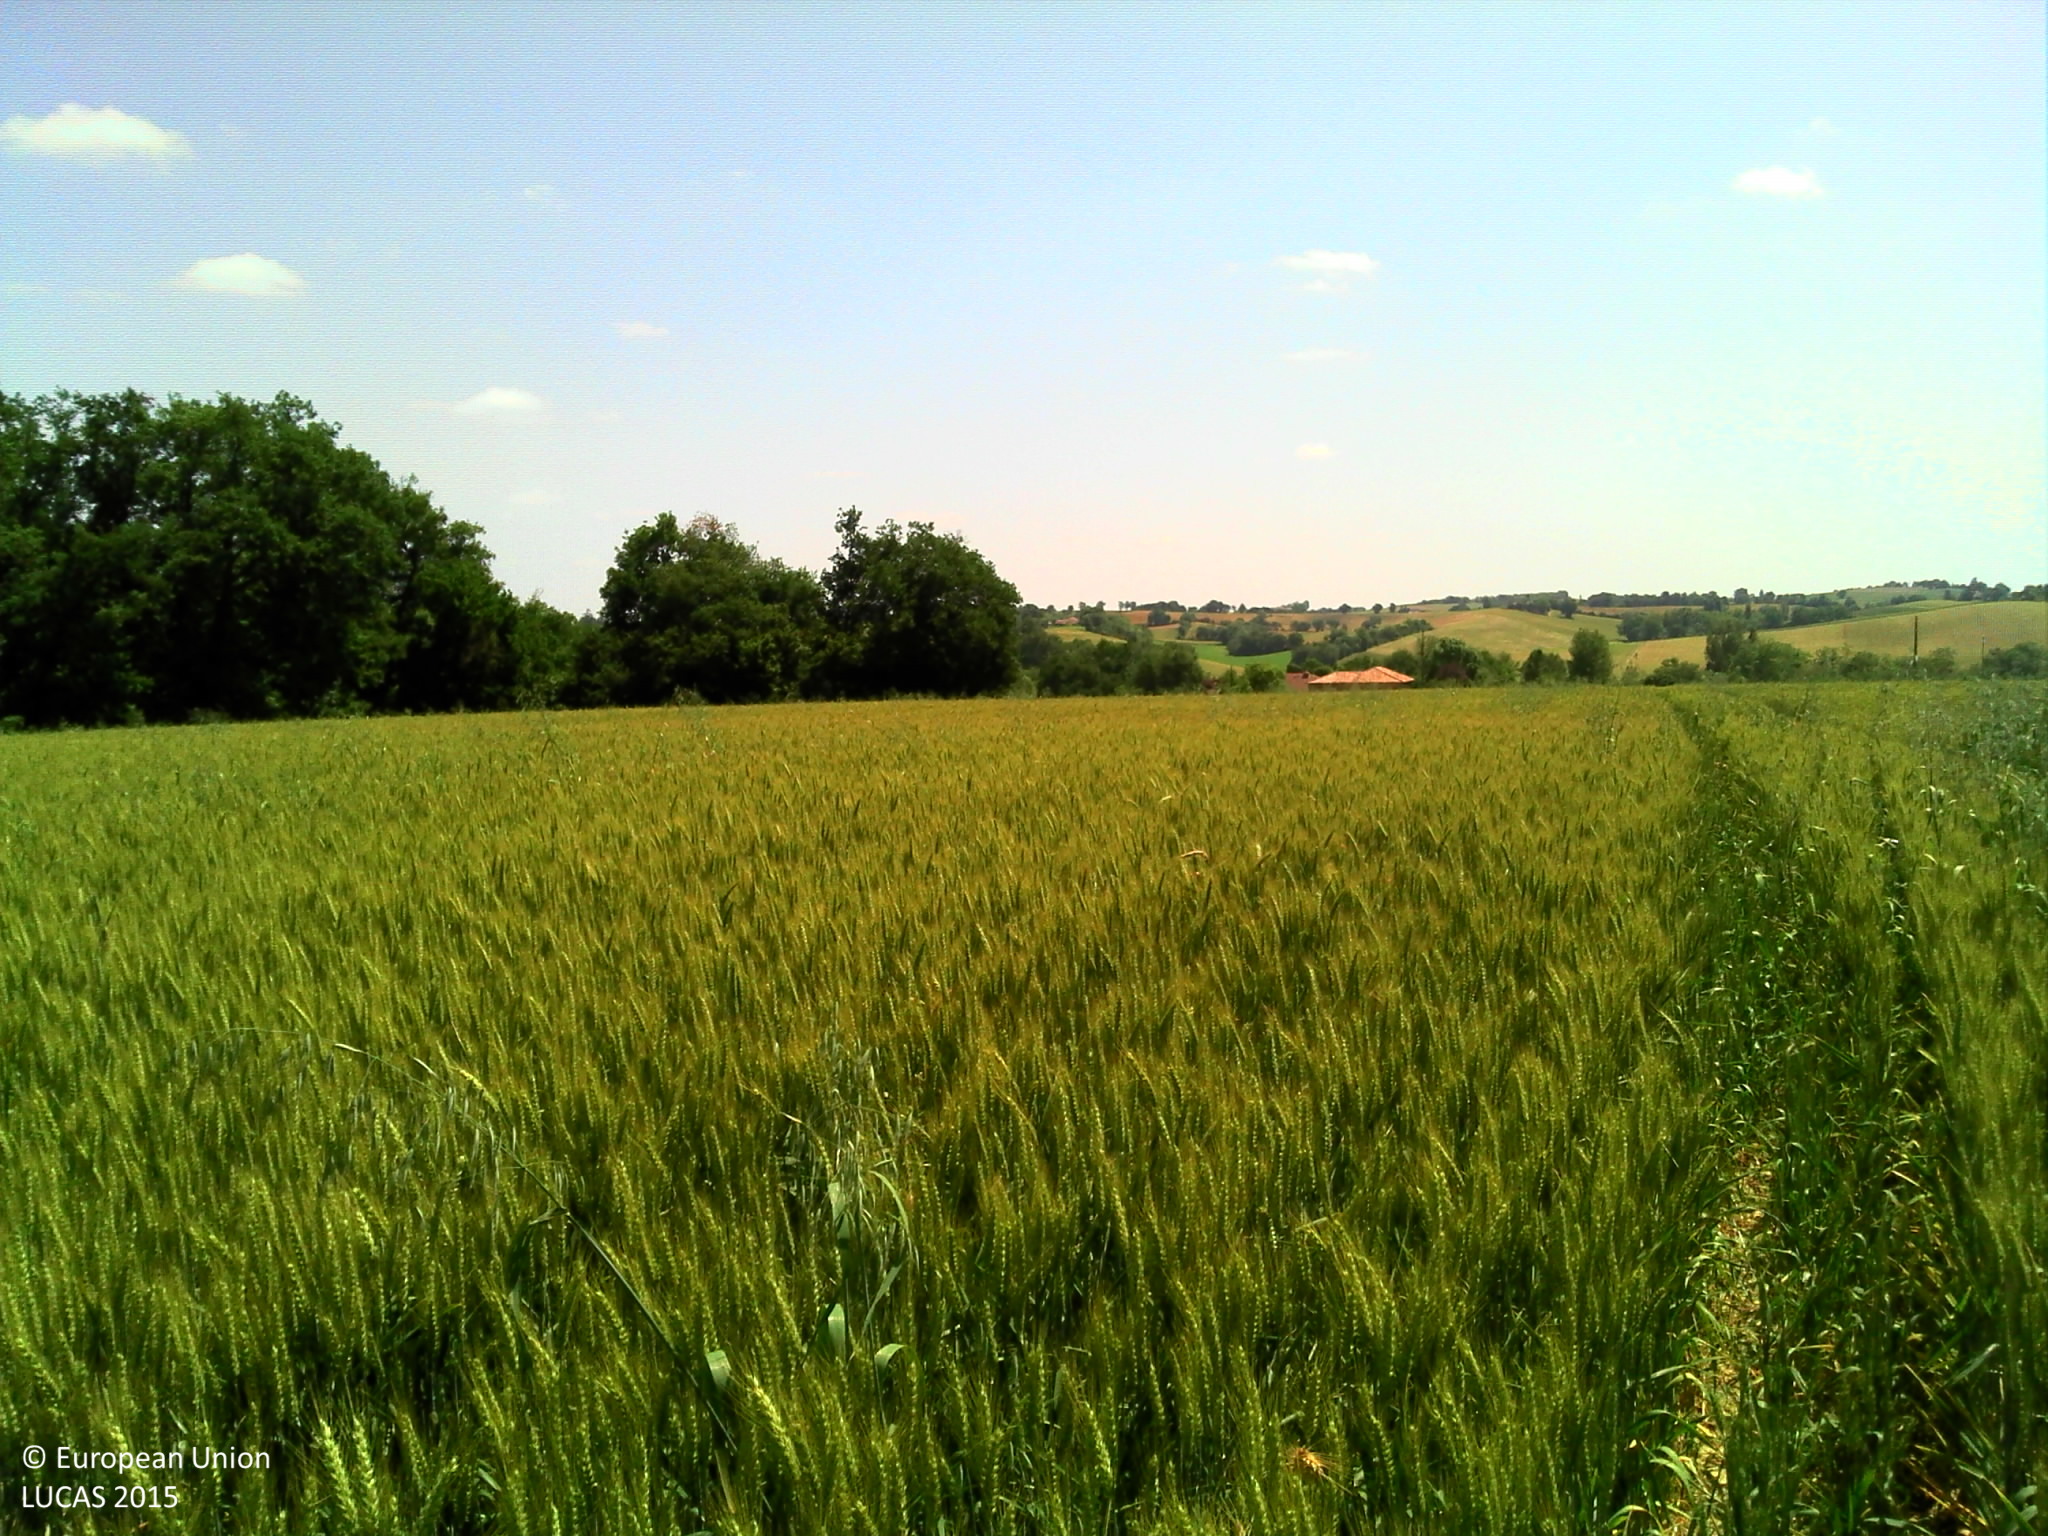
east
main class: Cropland
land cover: Common wheat
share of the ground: > 75 %
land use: Agriculture (excluding fallow land and kitchen gardens)
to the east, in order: Common wheat; Grass margins; Common wheat
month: June
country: FR
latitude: 43.6295
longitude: 0.7653
